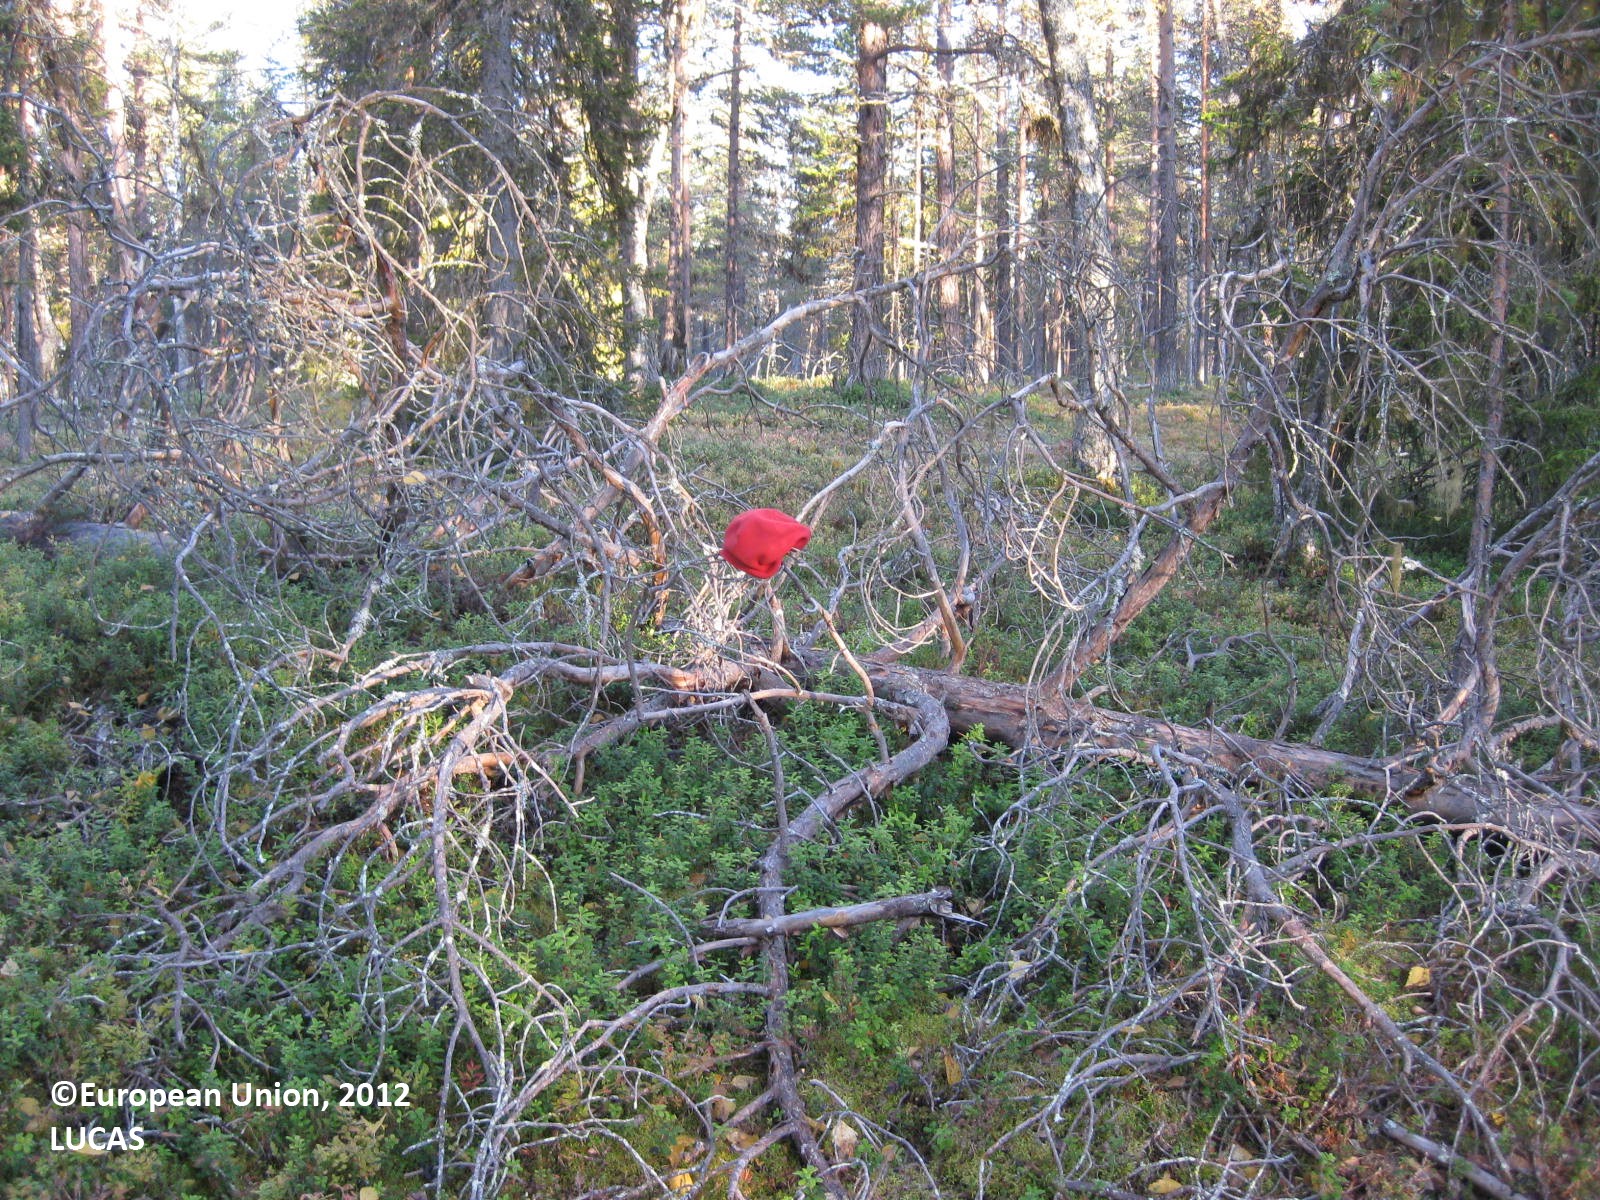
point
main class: Woodland
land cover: Other coniferous woodland
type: boreal forest
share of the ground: > 75 %
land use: Semi-natural and natural areas not in use
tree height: > 5 m
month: September
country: FI
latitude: 67.9583
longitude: 24.0332
